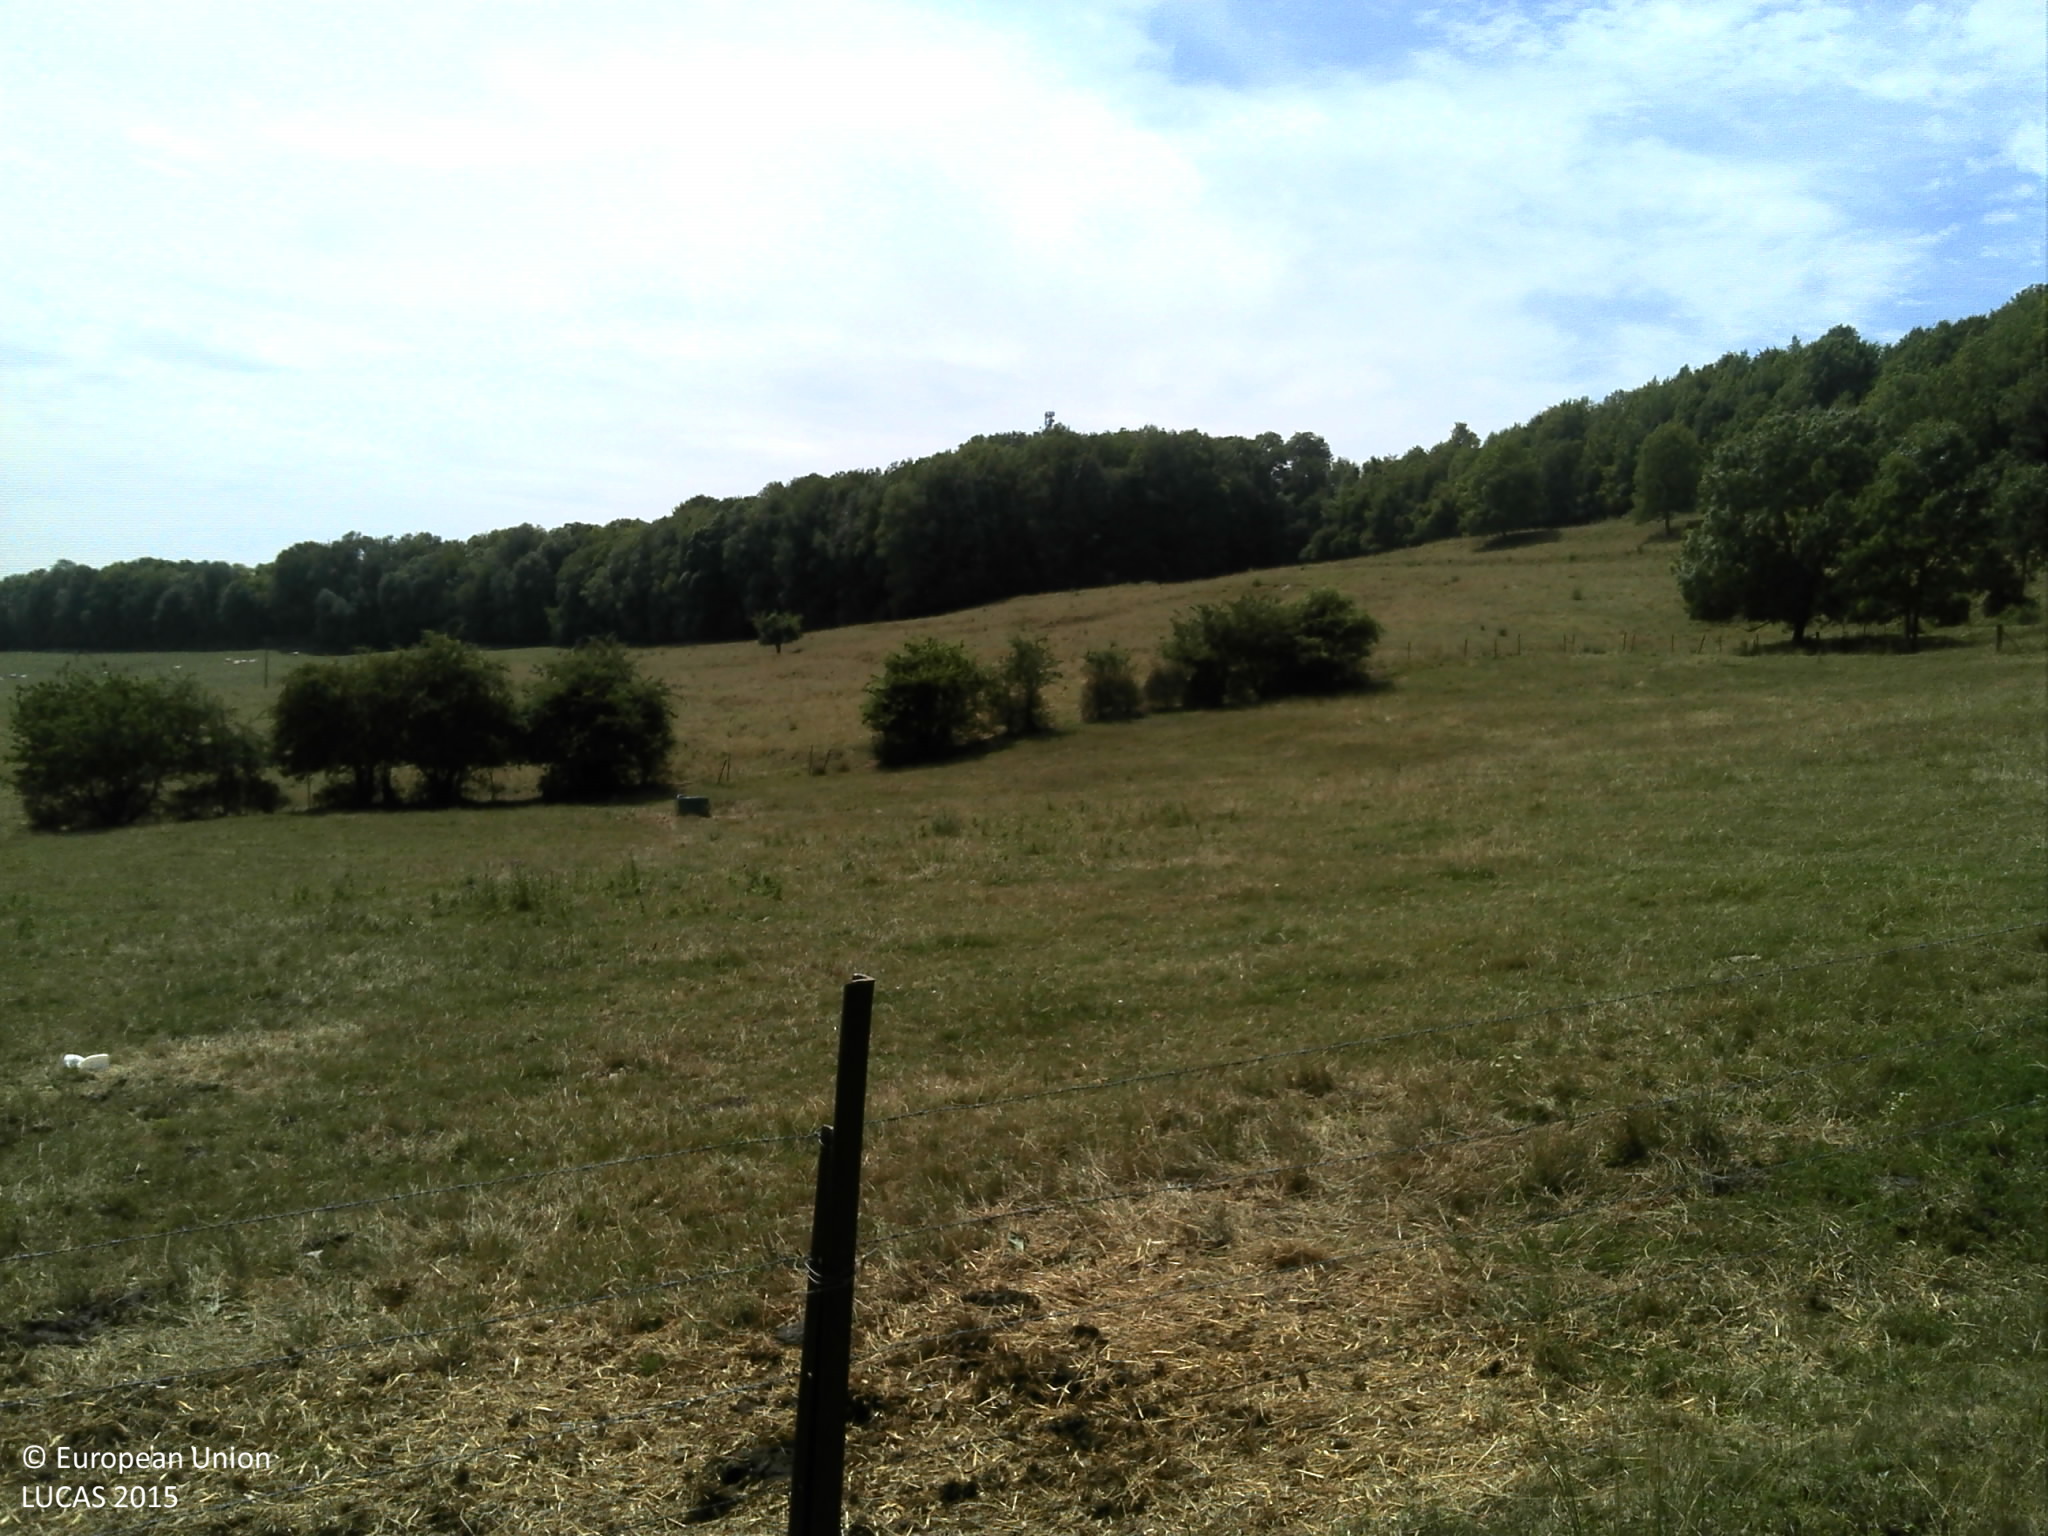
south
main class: Cropland
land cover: Clovers
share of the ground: > 75 %
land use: Agriculture (excluding fallow land and kitchen gardens)
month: July
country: FR
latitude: 49.6604
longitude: 4.2462
